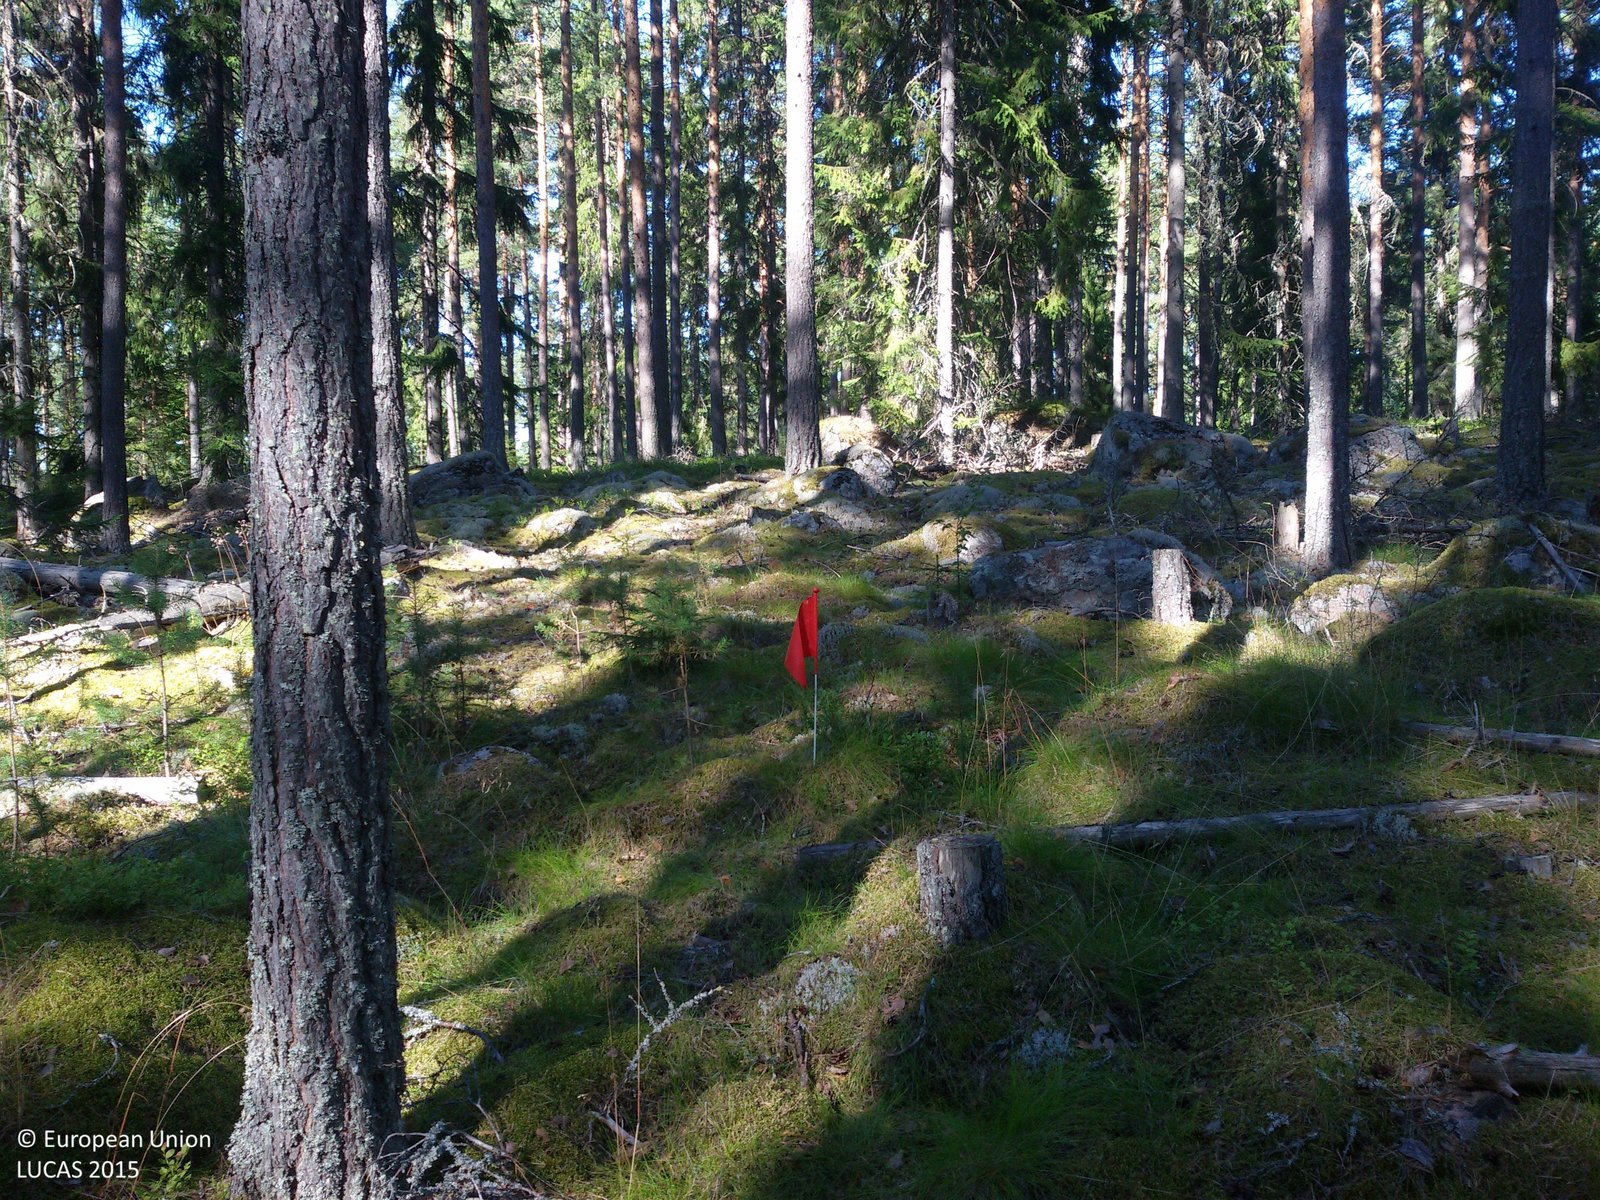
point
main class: Woodland
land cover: Pine dominated coniferous woodland
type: boreal forest
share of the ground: > 75 %
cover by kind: coniferous forest trees 75 %, lichens and mosses 15 %, shrubs 10 %
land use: Forestry
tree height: > 5 m
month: August
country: SE
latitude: 60.6728
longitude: 15.8625
